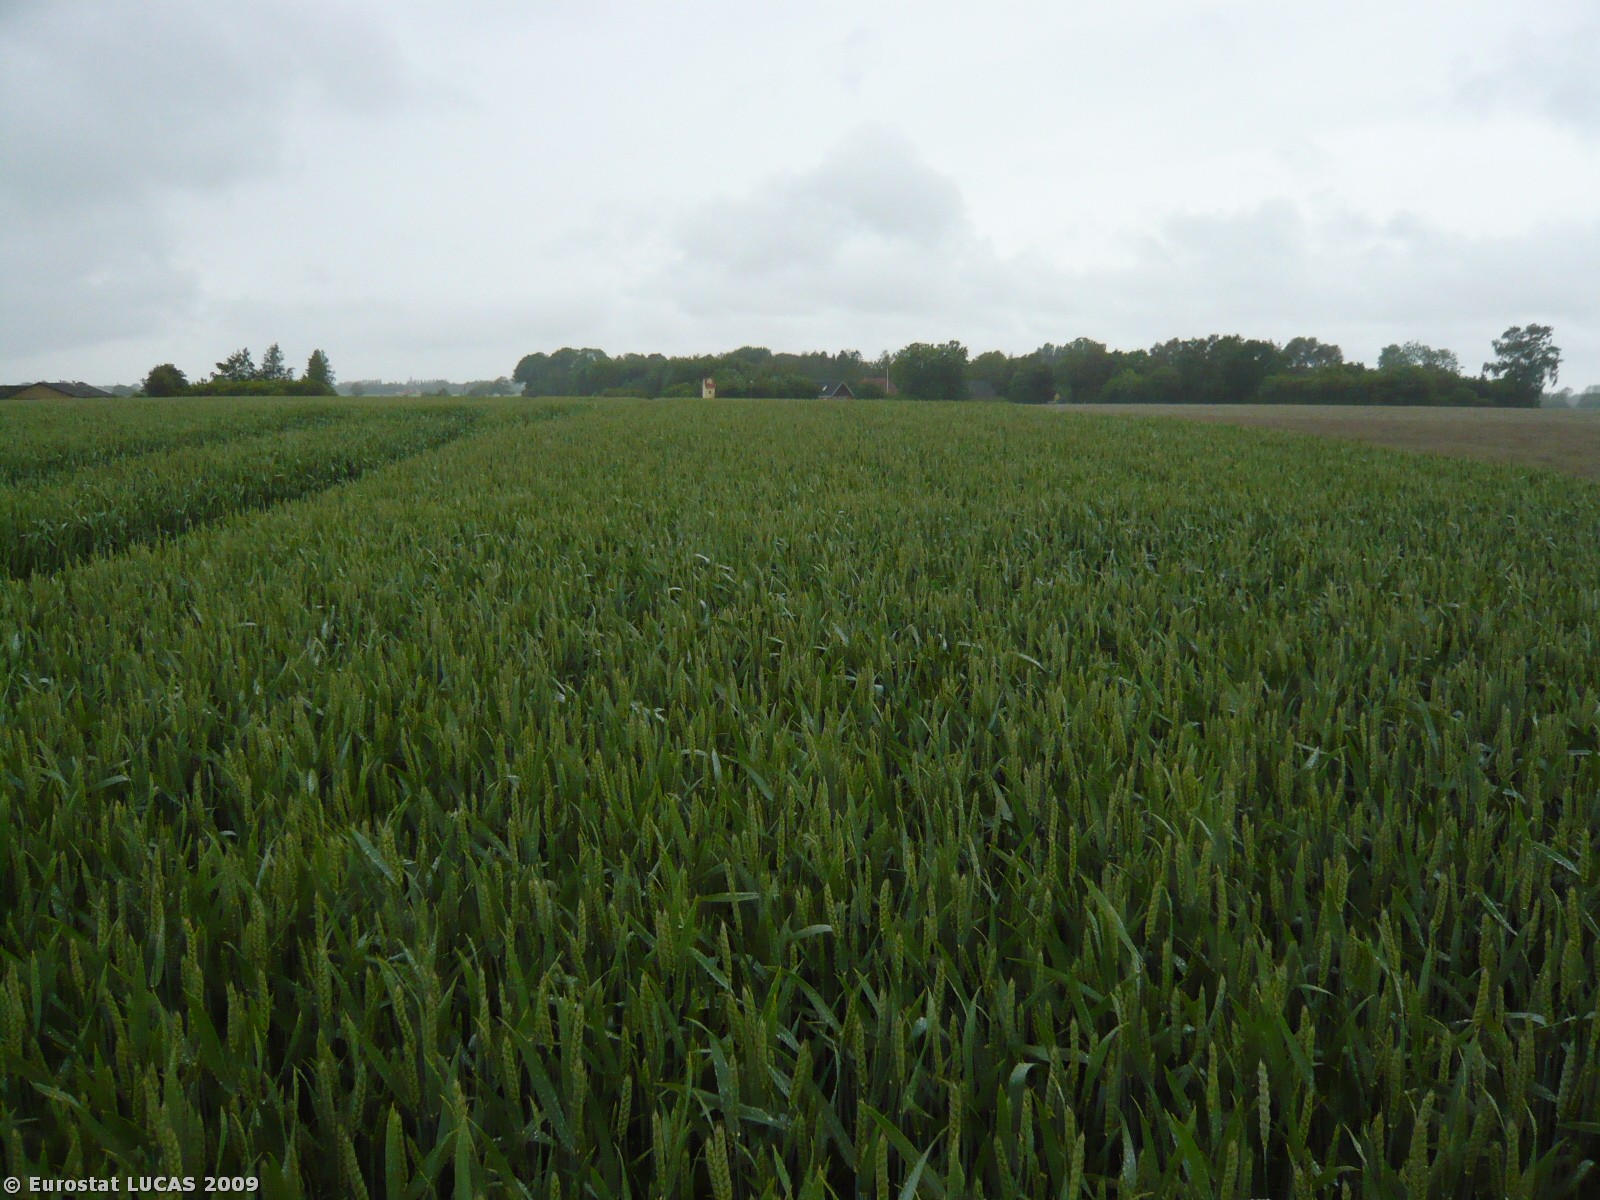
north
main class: Cropland
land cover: Common wheat
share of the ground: > 75 %
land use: Agriculture (excluding fallow land and kitchen gardens)
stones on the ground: 10 - 25 %
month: June
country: DK
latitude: 54.7882
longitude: 11.9738
